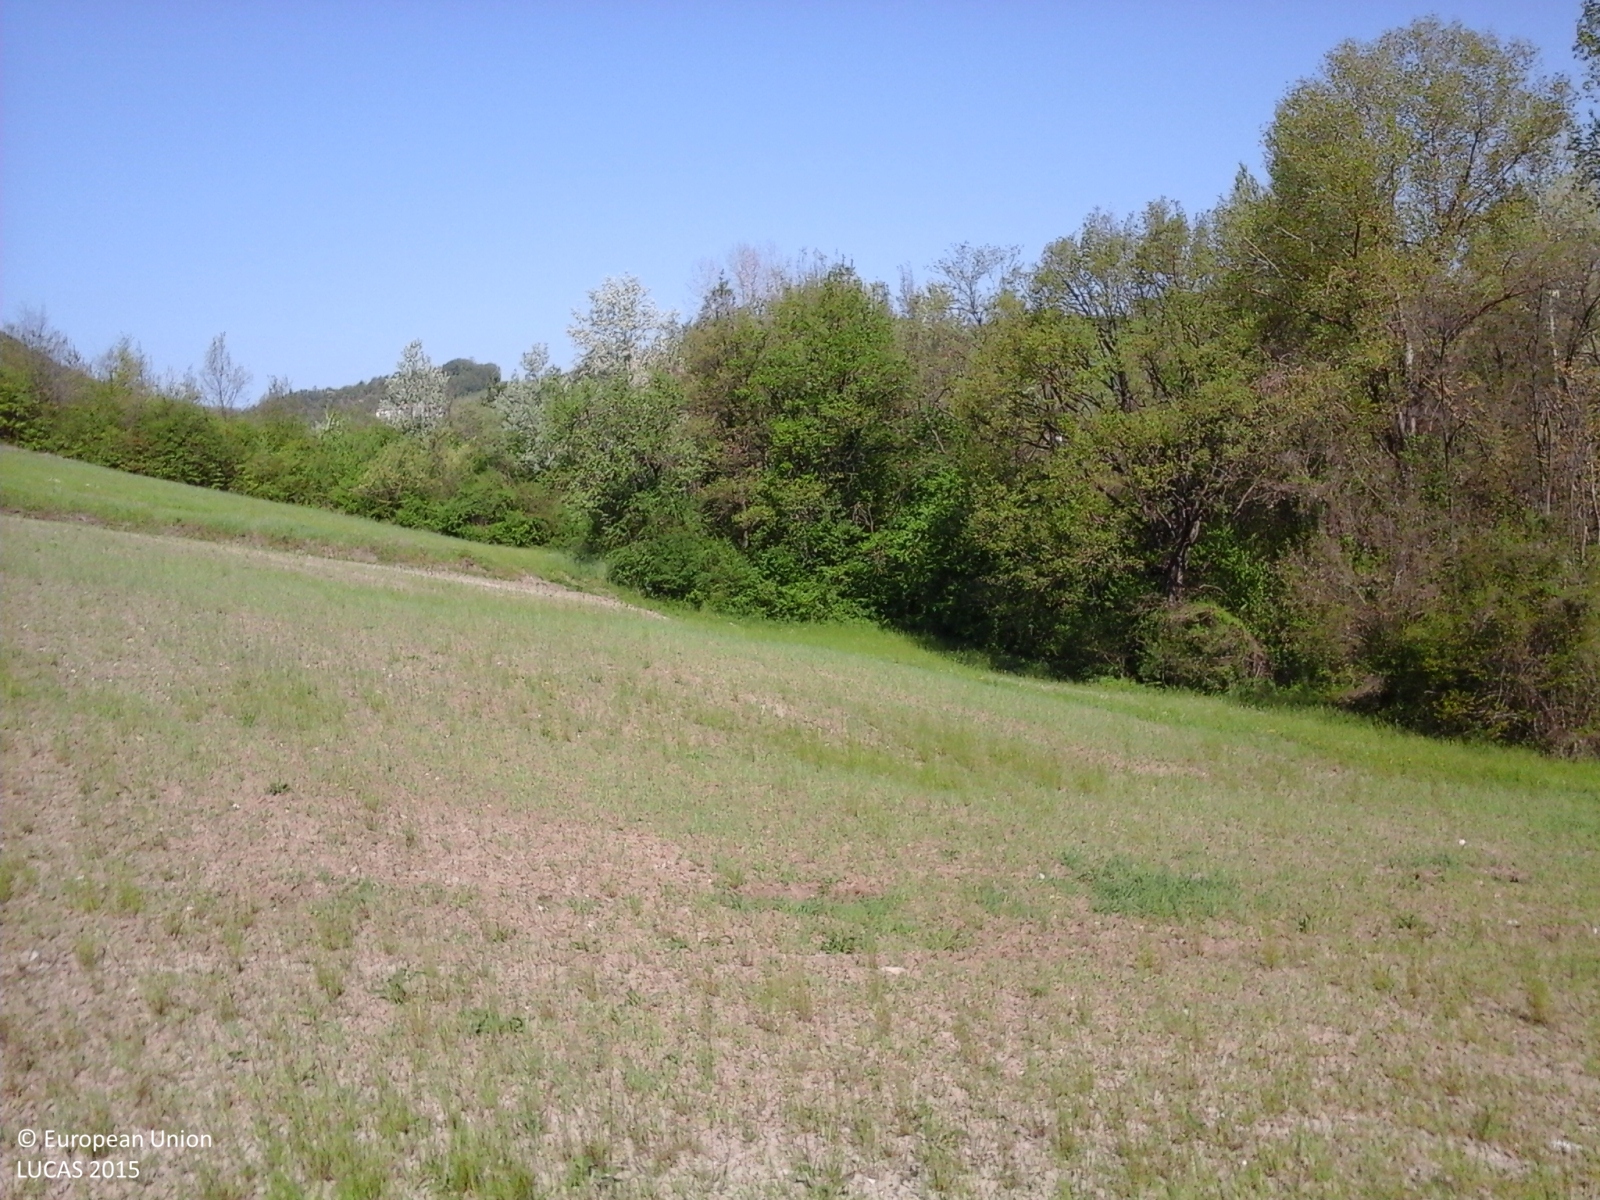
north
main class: Grassland
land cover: Spontaneously vegetated surfaces
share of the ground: 10 - 25 %
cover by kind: herbaceous plants 80 %, unconsolidated bare surface 20 %
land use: Agriculture (excluding fallow land and kitchen gardens)
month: April
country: IT
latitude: 44.9072
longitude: 9.3048
